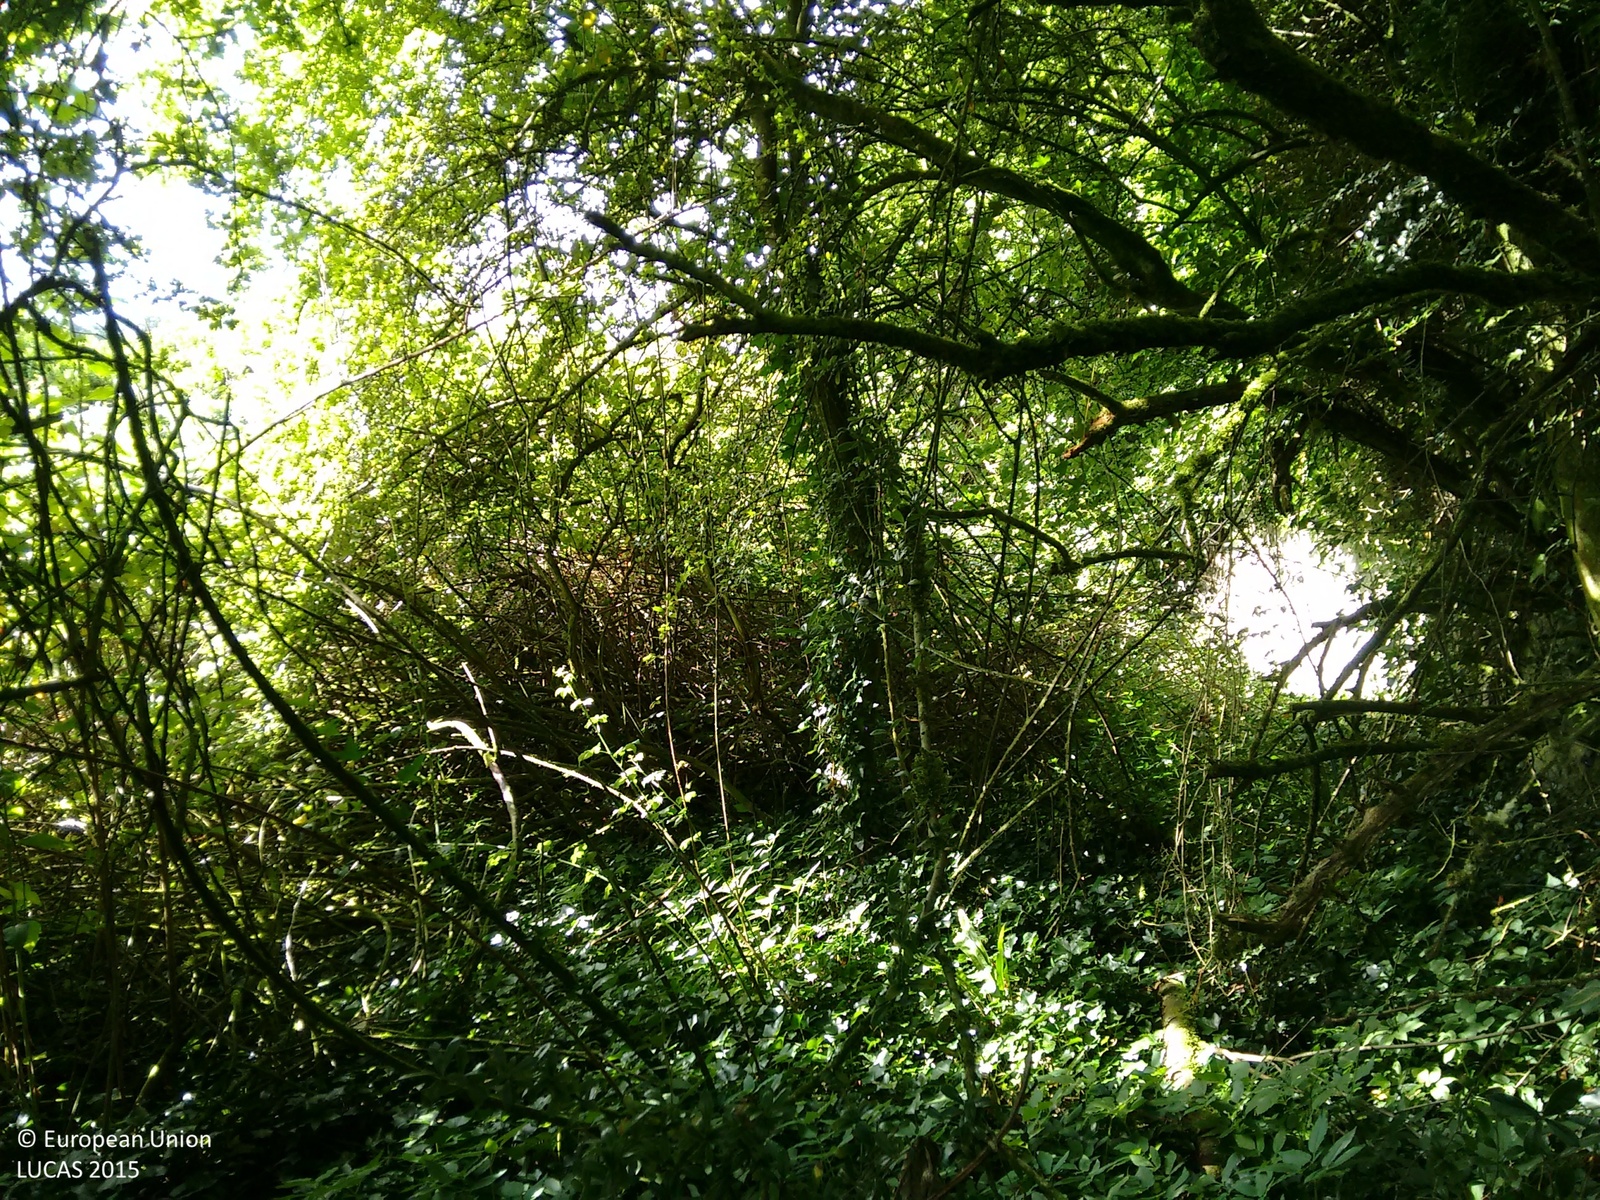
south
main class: Woodland
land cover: Broadleaved woodland
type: acidophilous oak and oak-birch forest
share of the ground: > 75 %
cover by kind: broadleaved forest trees 95 %, shrubs 5 %
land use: Semi-natural and natural areas not in use
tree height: > 5 m
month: July
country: IE
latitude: 52.7299
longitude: -7.4380
